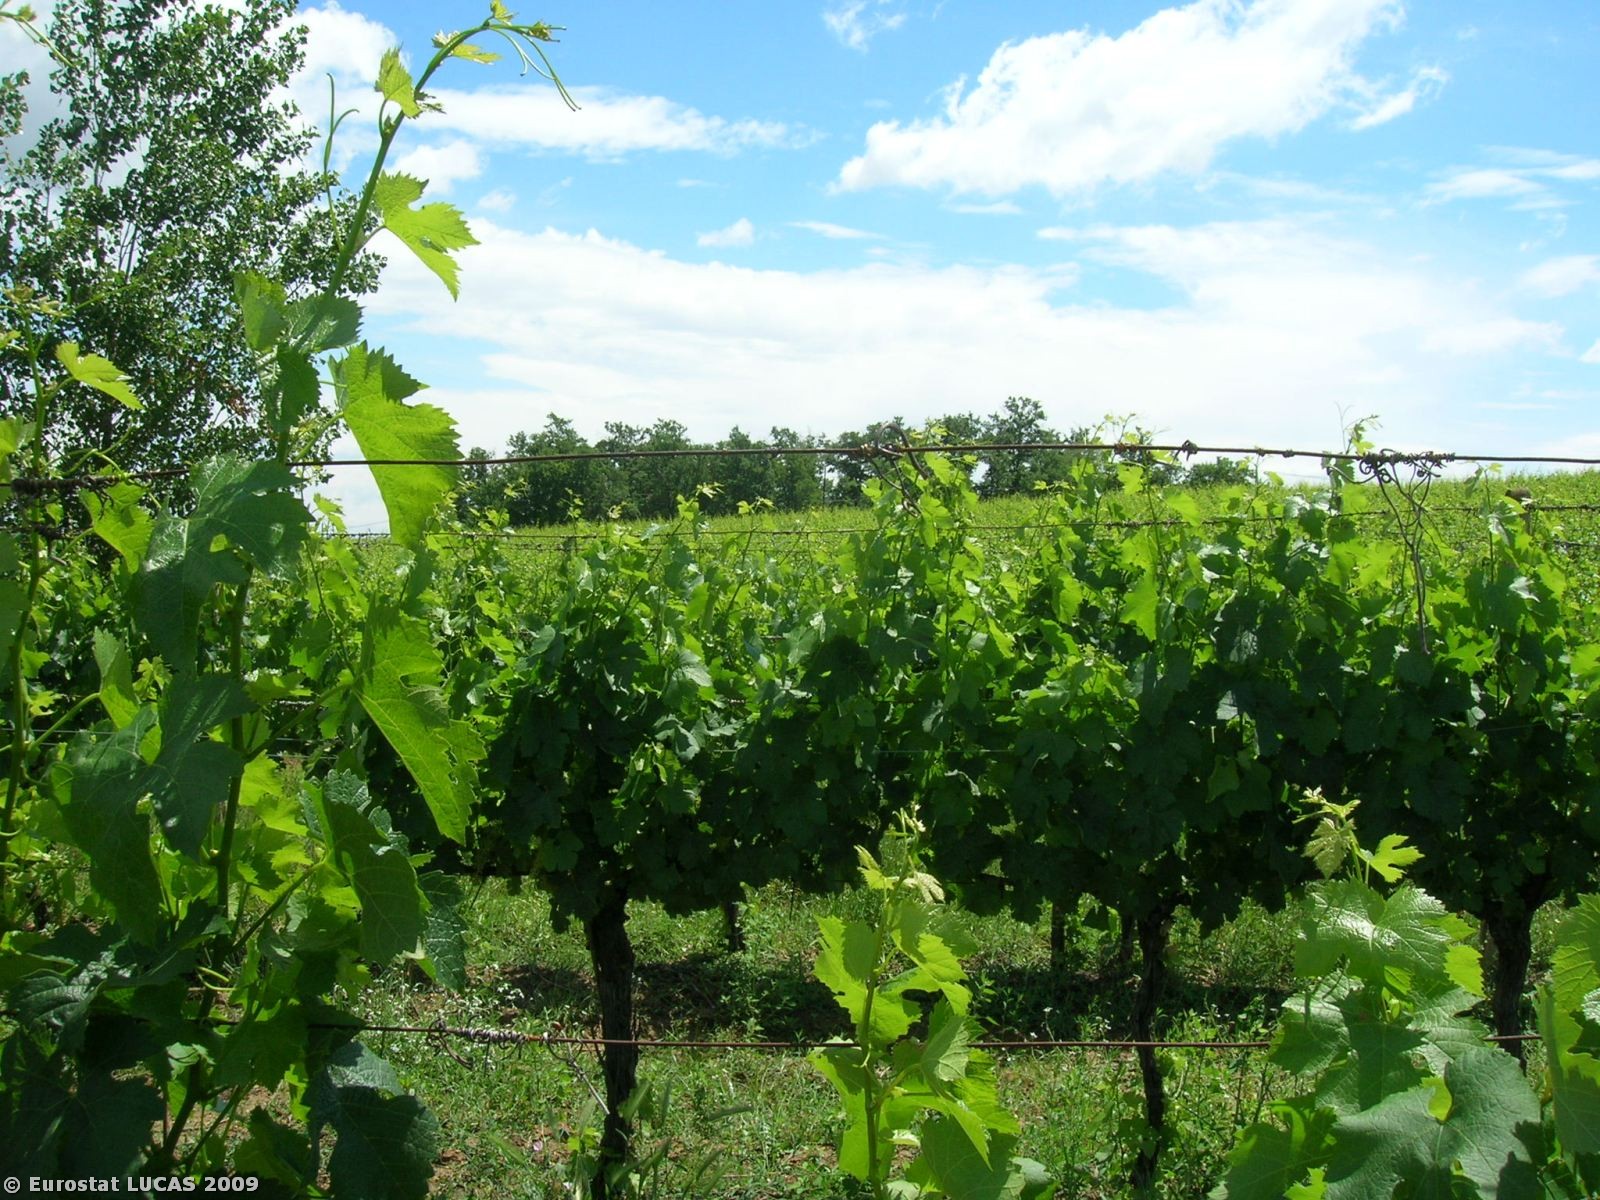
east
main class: Cropland
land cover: Vineyards
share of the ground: 25 - 50 %
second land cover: Spontaneously vegetated surfaces
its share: > 75 %
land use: Agriculture (excluding fallow land and kitchen gardens)
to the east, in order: Vineyards; Spontaneously vegetated surfaces; Ditches and canals; Vineyards; Spontaneously vegetated surfaces; Paved roads, cycling and walking lanes; Vineyards; Bare land
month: June
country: IT
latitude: 43.1067
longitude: 11.8500
